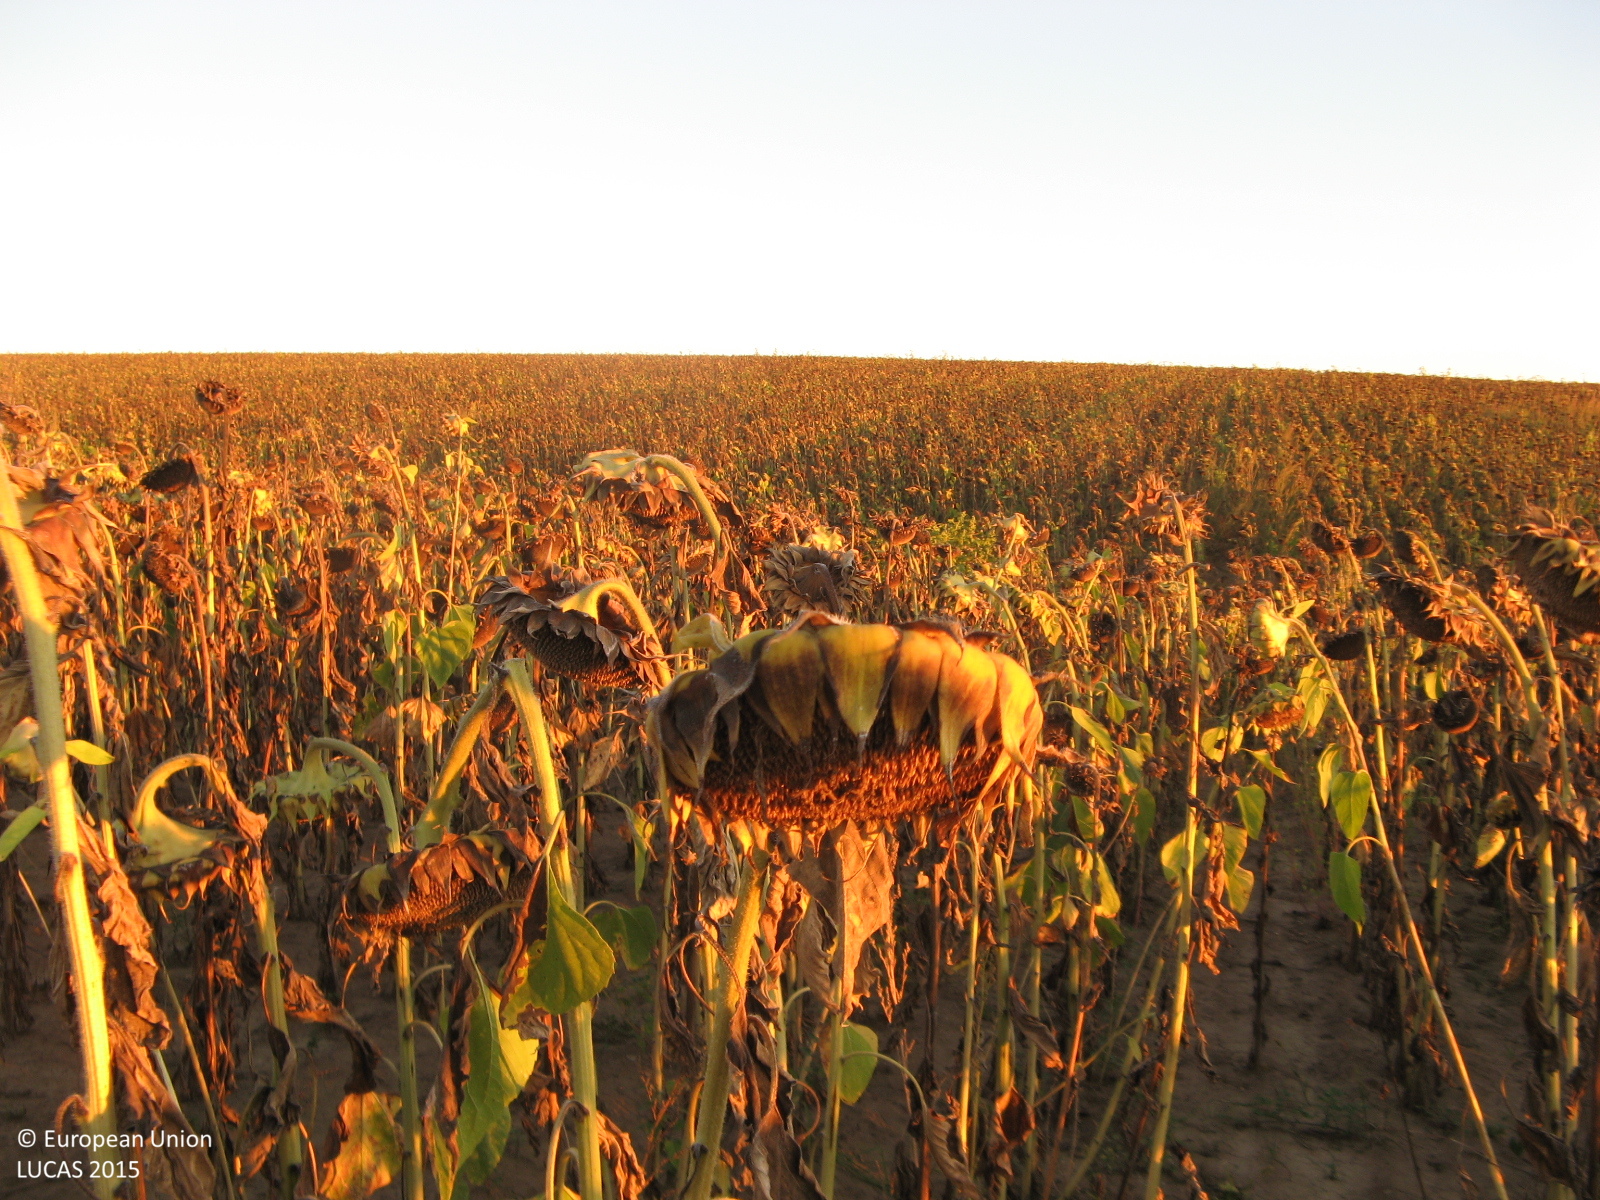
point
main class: Cropland
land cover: Sunflower
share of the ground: > 75 %
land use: Agriculture (excluding fallow land and kitchen gardens)
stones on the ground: < 10 %
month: September
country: BG
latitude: 43.5681
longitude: 26.0543
